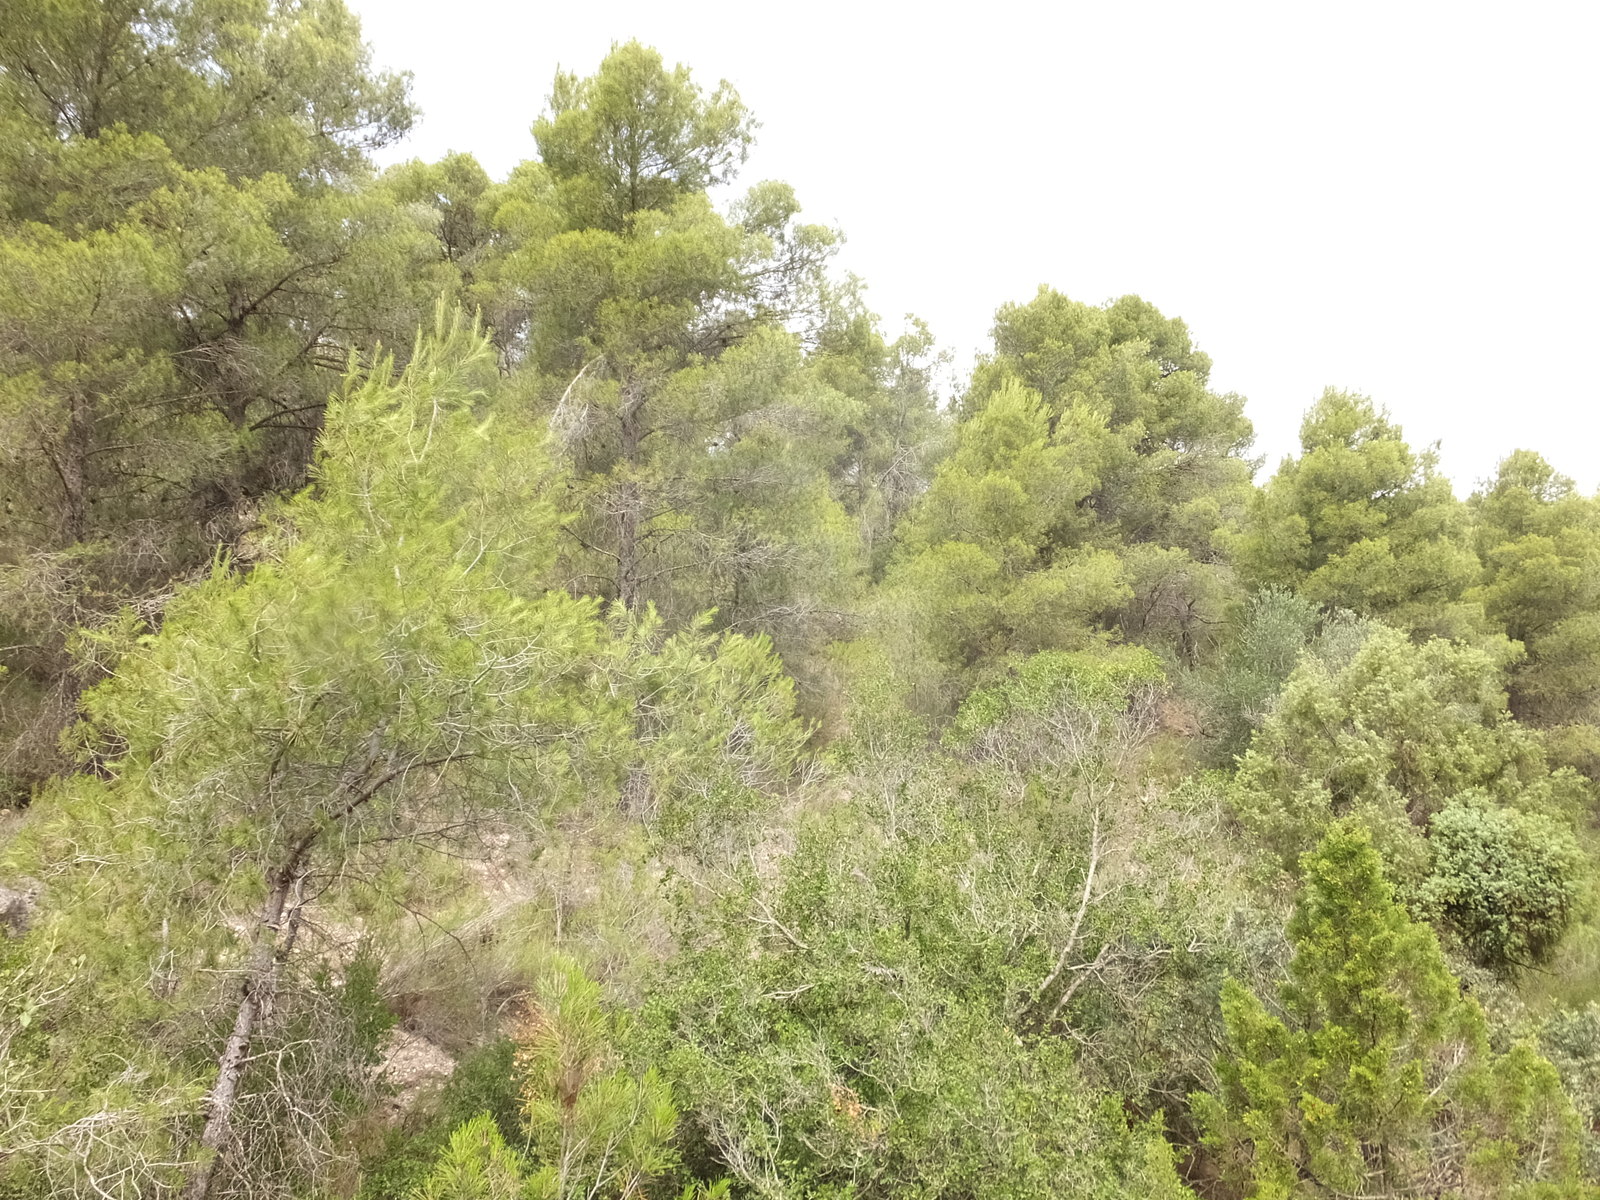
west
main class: Woodland
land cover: Pine dominated mixed woodland
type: coniferous forest of the mediterranean region
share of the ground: 50 - 75 %
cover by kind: coniferous forest trees 60 %, broadleaved forest trees 20 %, shrubs 20 %
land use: Forestry
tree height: > 5 m
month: July
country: ES
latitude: 41.3730
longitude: 0.3397
